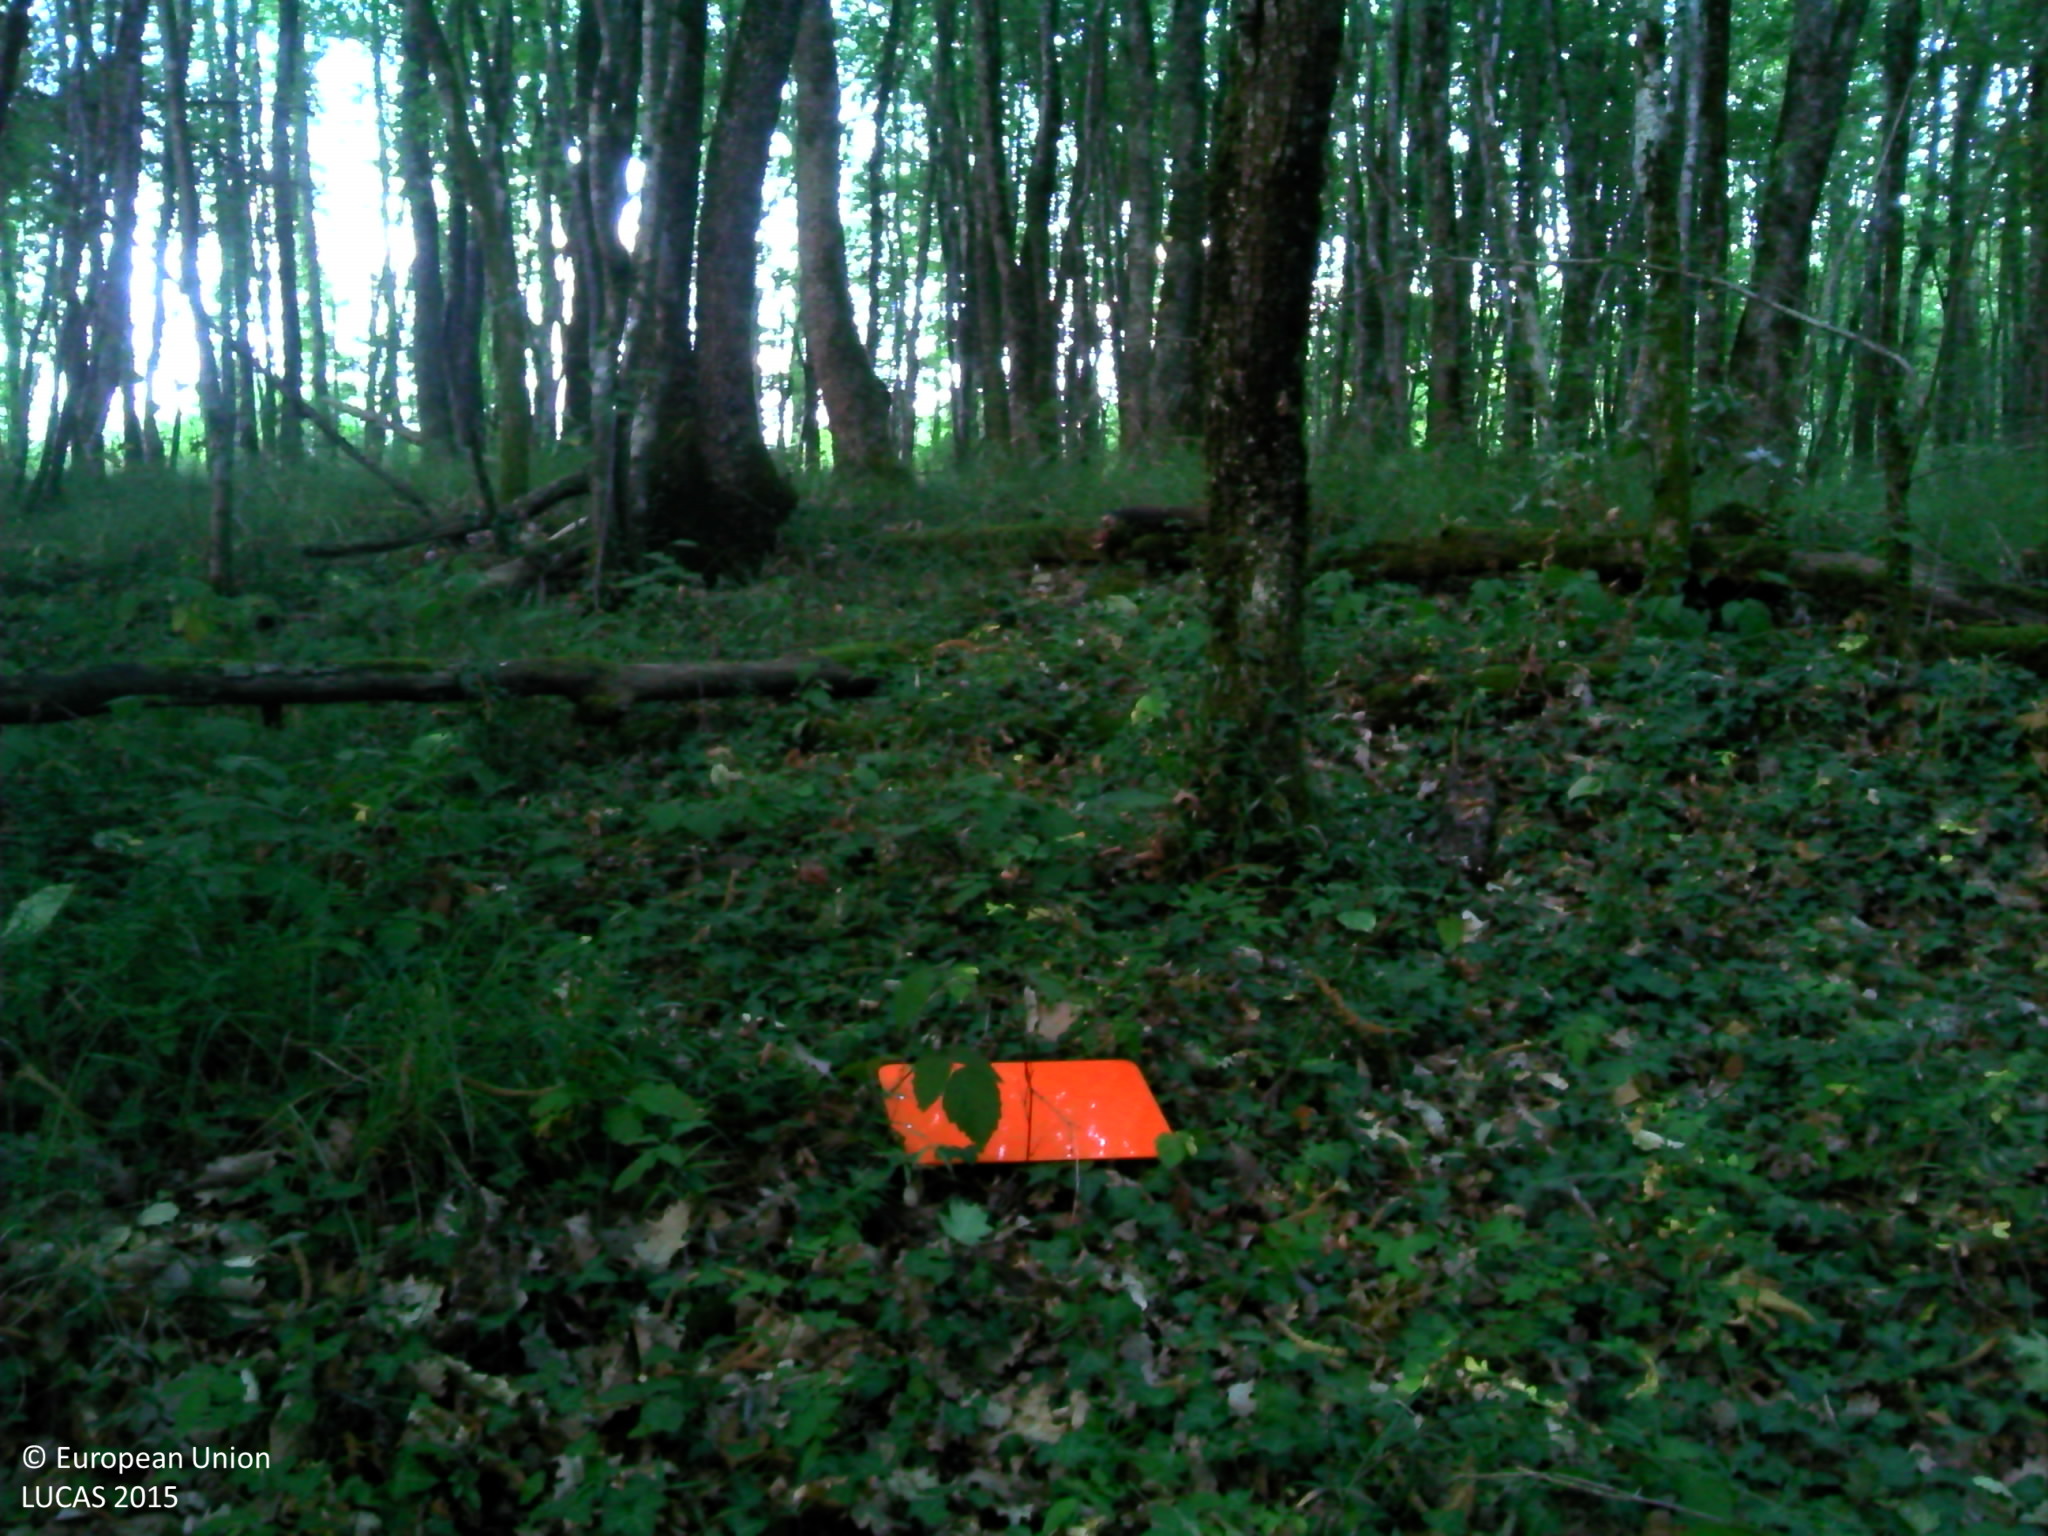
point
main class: Woodland
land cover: Broadleaved woodland
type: thermophilous deciduous forest
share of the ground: > 75 %
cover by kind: broadleaved forest trees 90 %, herbaceous plants 10 %
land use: Forestry
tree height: > 5 m
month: July
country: FR
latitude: 44.3270
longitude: 0.6519
